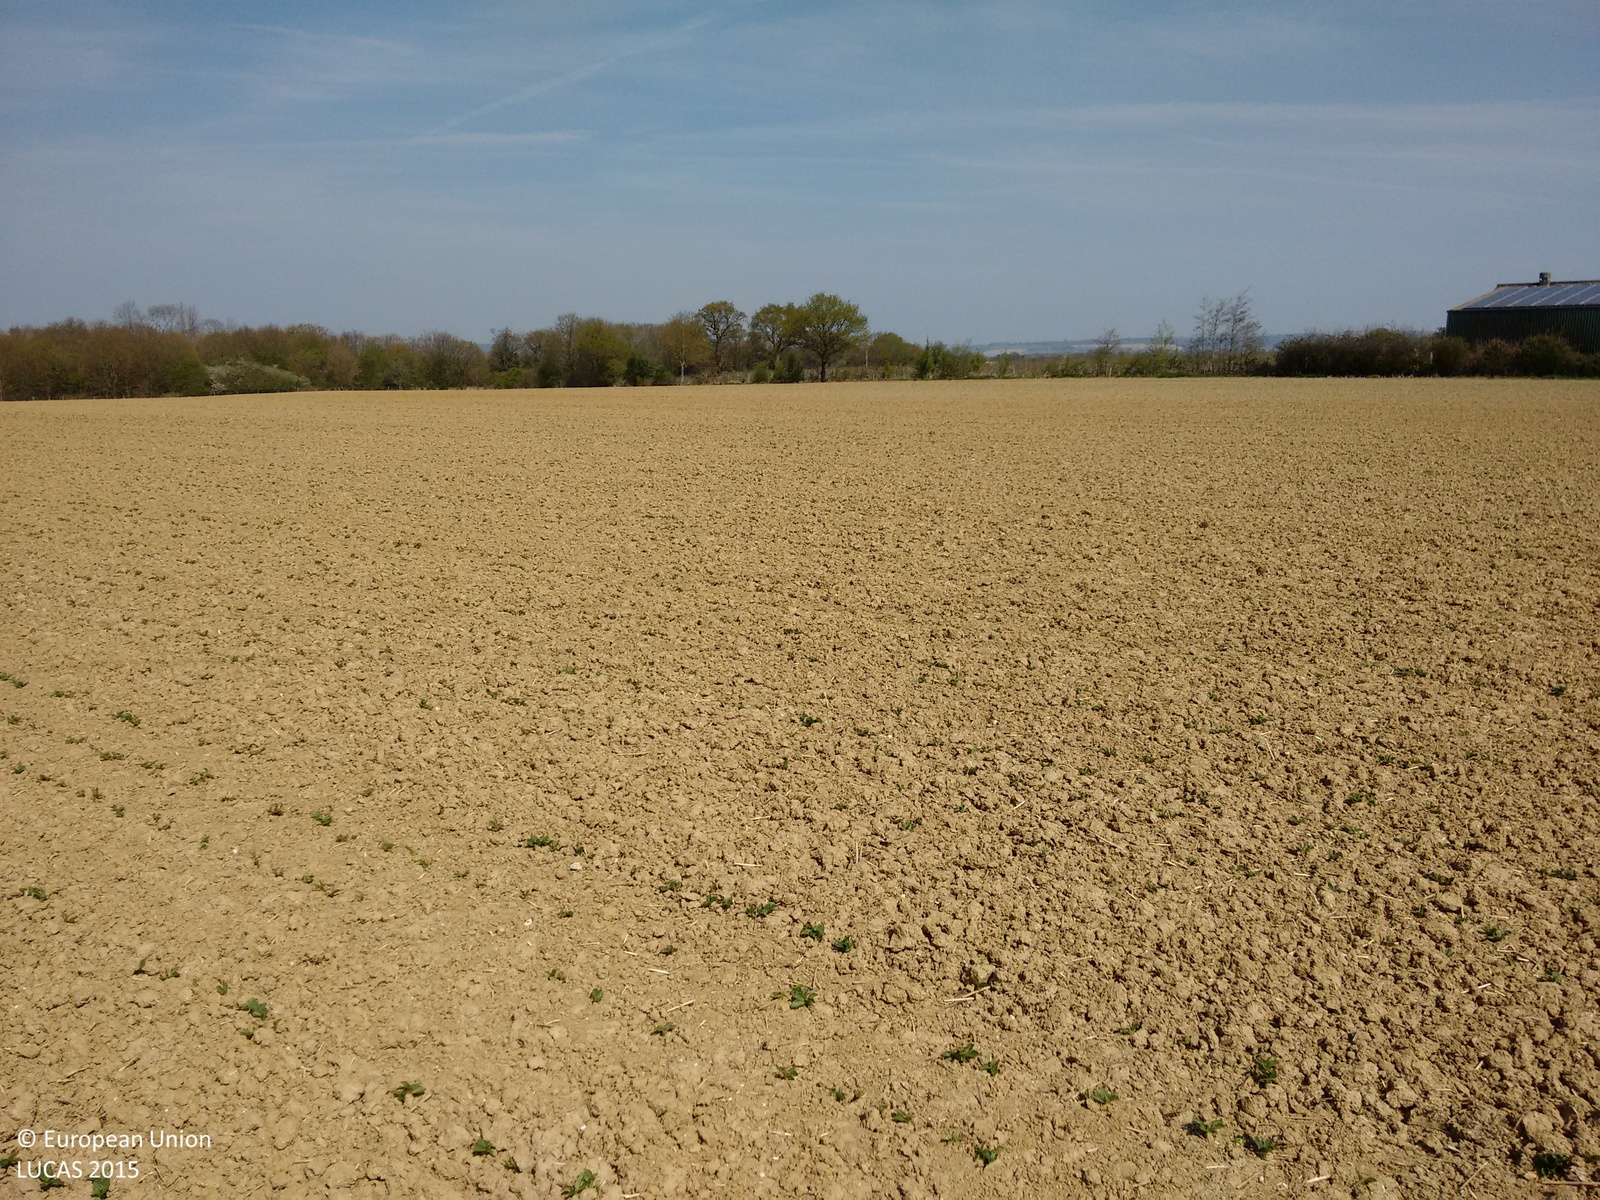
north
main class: Cropland
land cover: Dry pulses
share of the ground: < 10 %
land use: Agriculture (excluding fallow land and kitchen gardens)
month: April
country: GB
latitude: 51.1729
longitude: 0.4024
